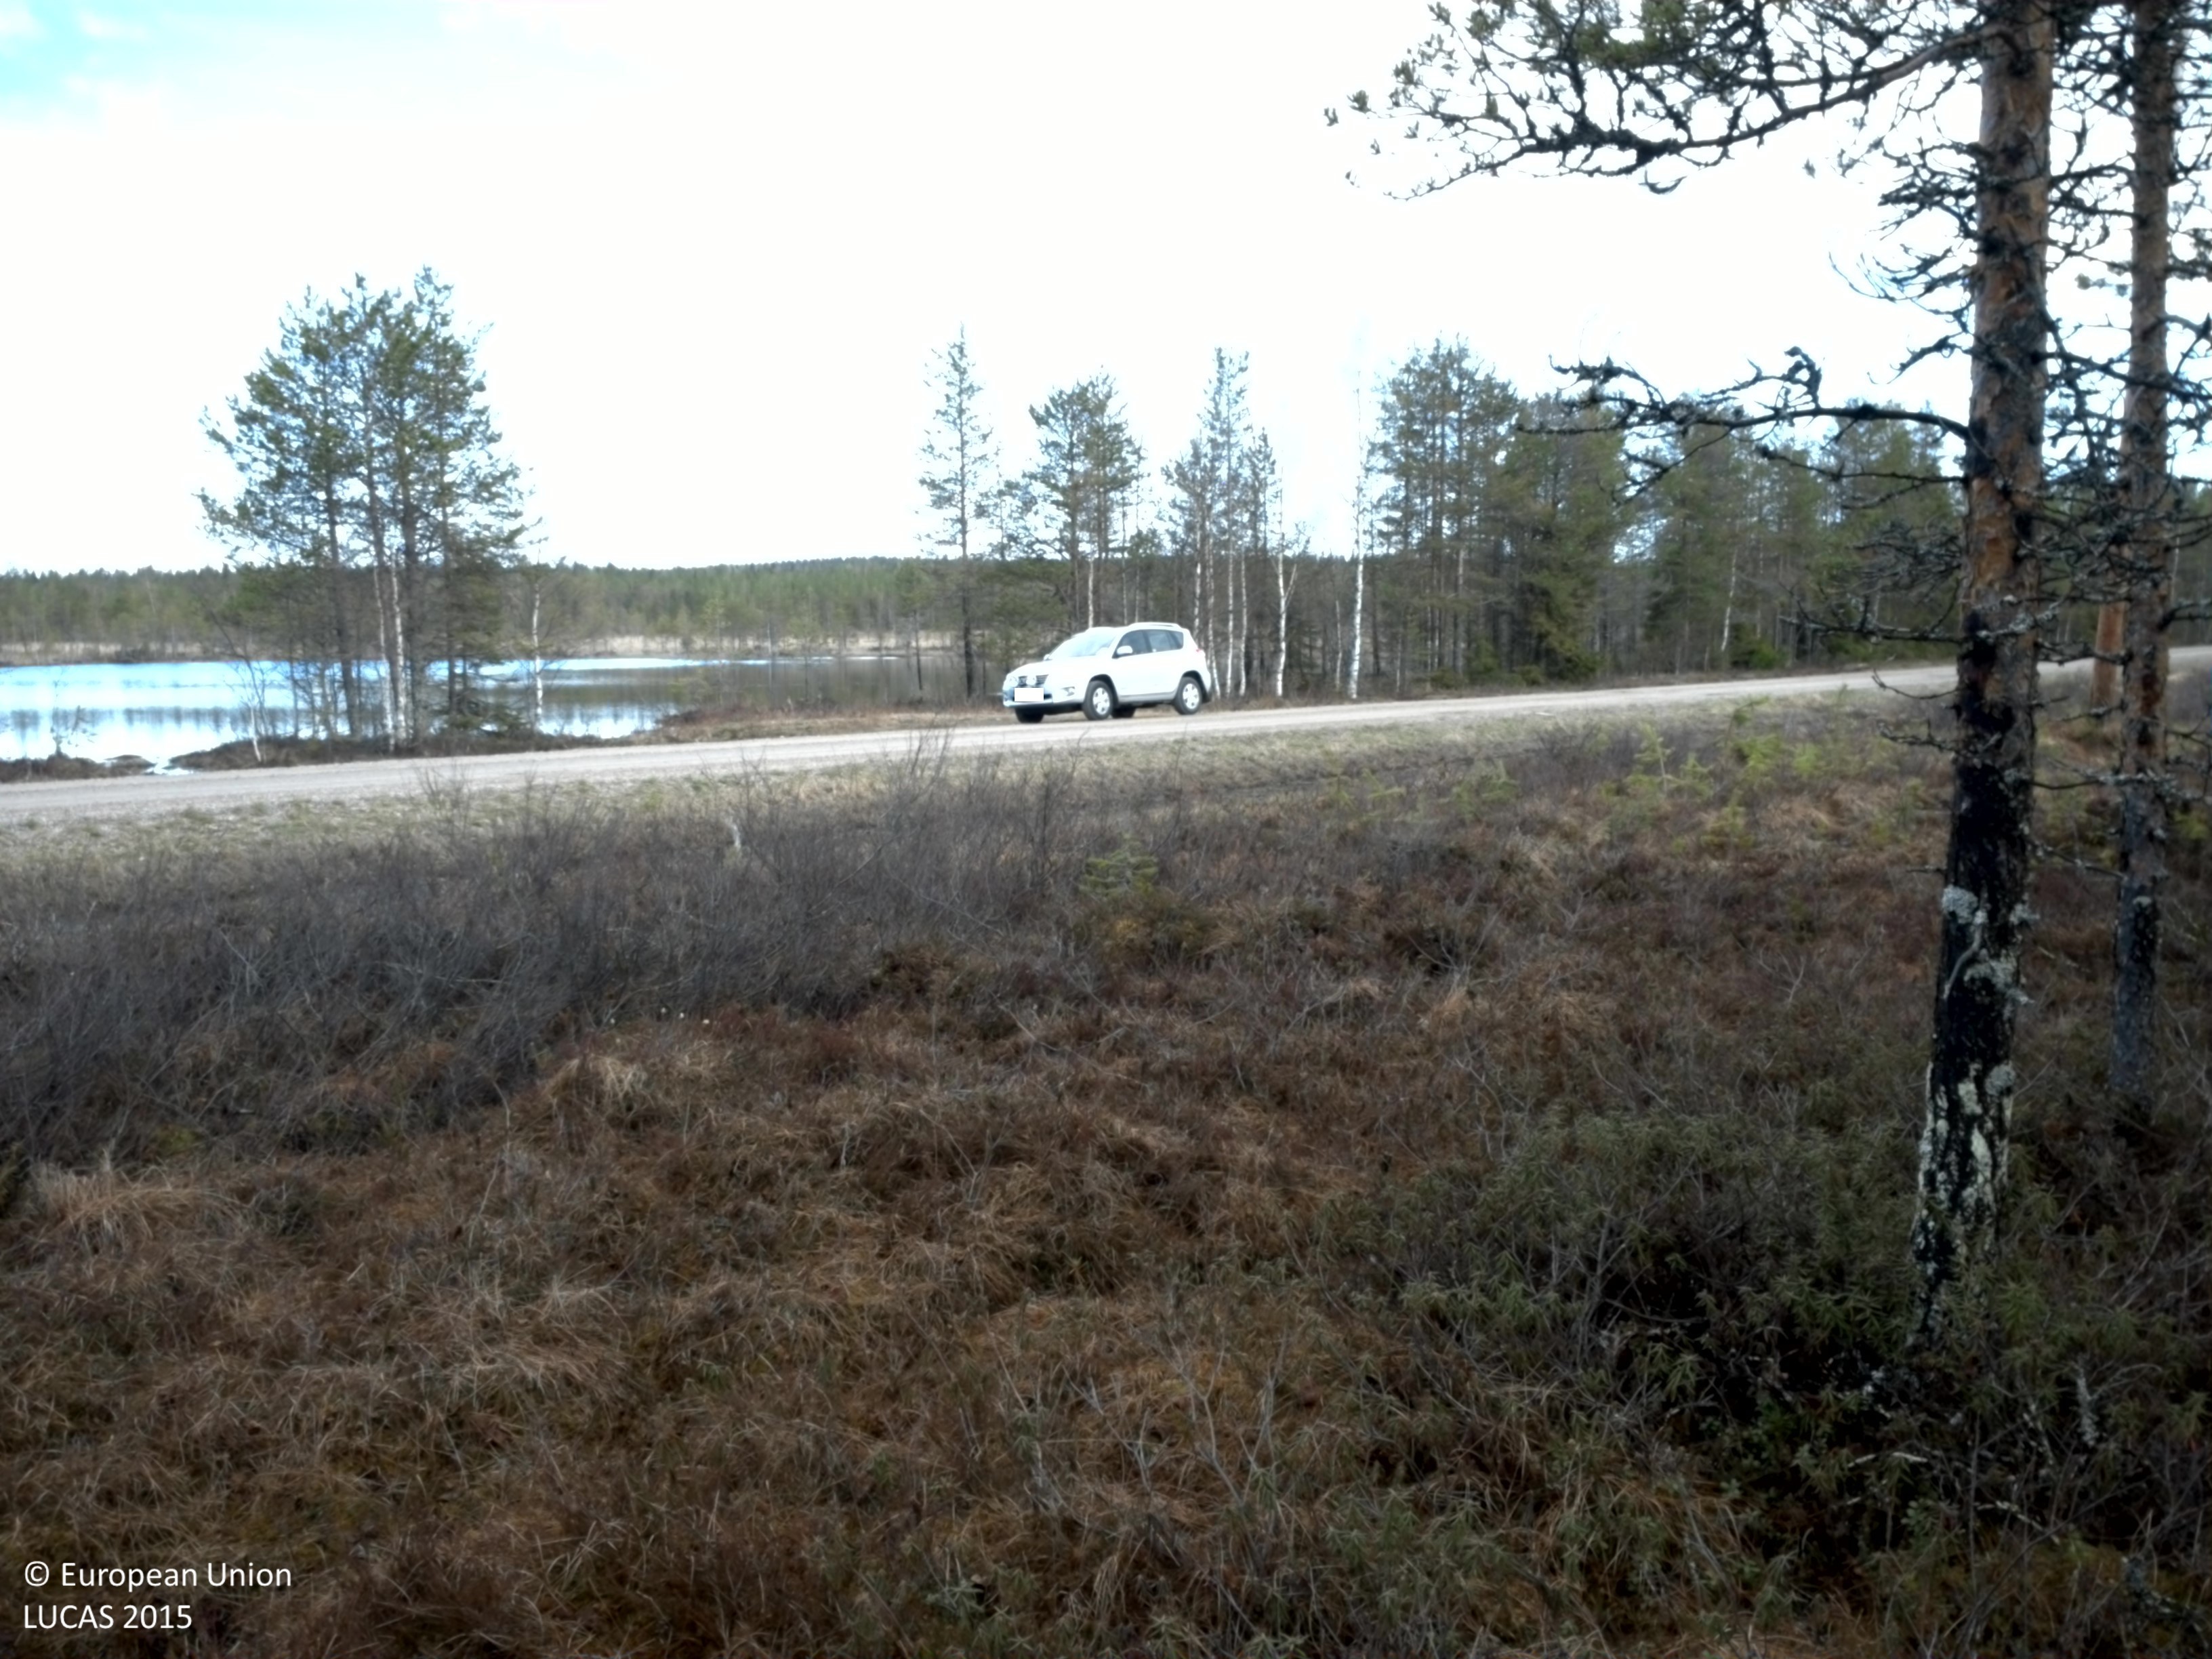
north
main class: Woodland
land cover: Pine dominated coniferous woodland
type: boreal forest
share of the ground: > 75 %
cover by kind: coniferous forest trees 80 %, shrubs 20 %
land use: Forestry
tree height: > 5 m
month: May
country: SE
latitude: 66.1979
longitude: 23.4214
